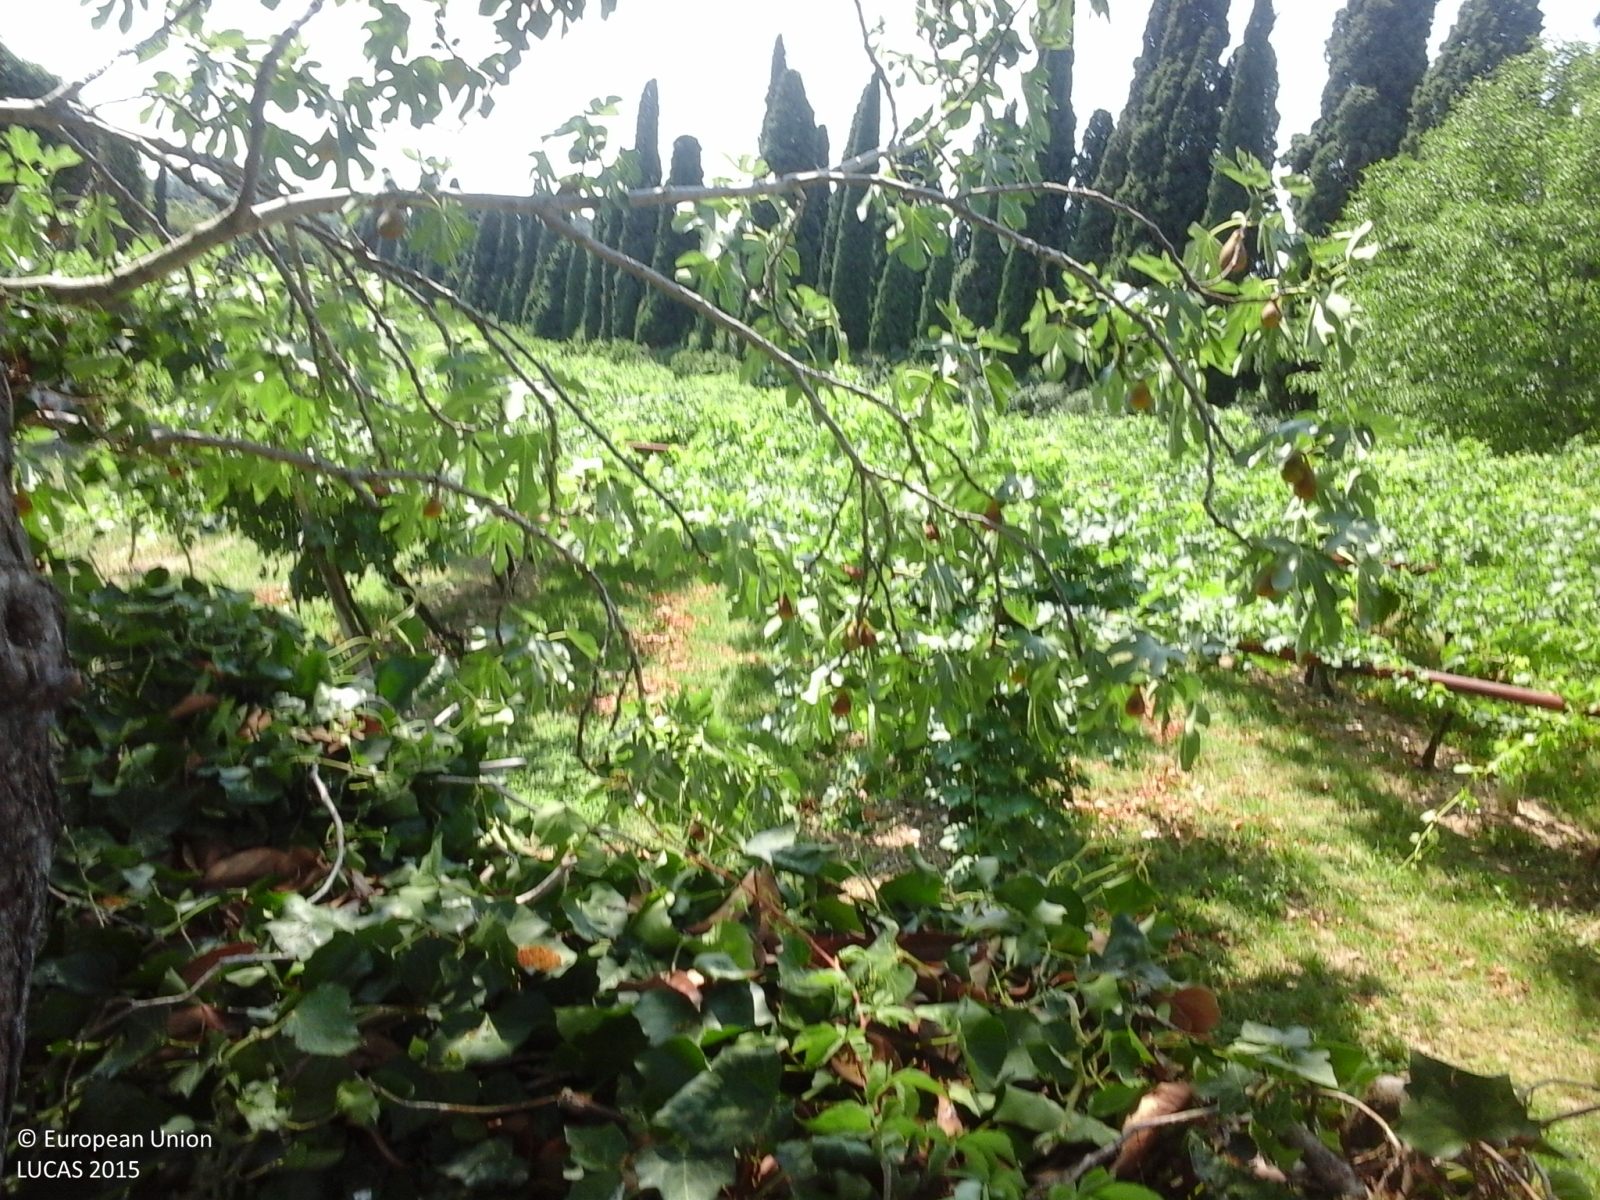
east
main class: Cropland
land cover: Vineyards
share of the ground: > 75 %
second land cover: Grassland without tree/shrub cover
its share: > 75 %
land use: Agriculture (excluding fallow land and kitchen gardens)
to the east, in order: Vineyards; Grassland without tree/shrub cover; Artificial constructions in urban areas; Grassland without tree/shrub cover; Broadleaved woodland; Olive groves; Grassland without tree/shrub cover; Abandoned hedges; Tracks; Abandoned hedges; Cherry fruit; Olive groves; Tracks; Grassland without tree/shrub cover
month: July
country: IT
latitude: 45.4813
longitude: 11.0345
